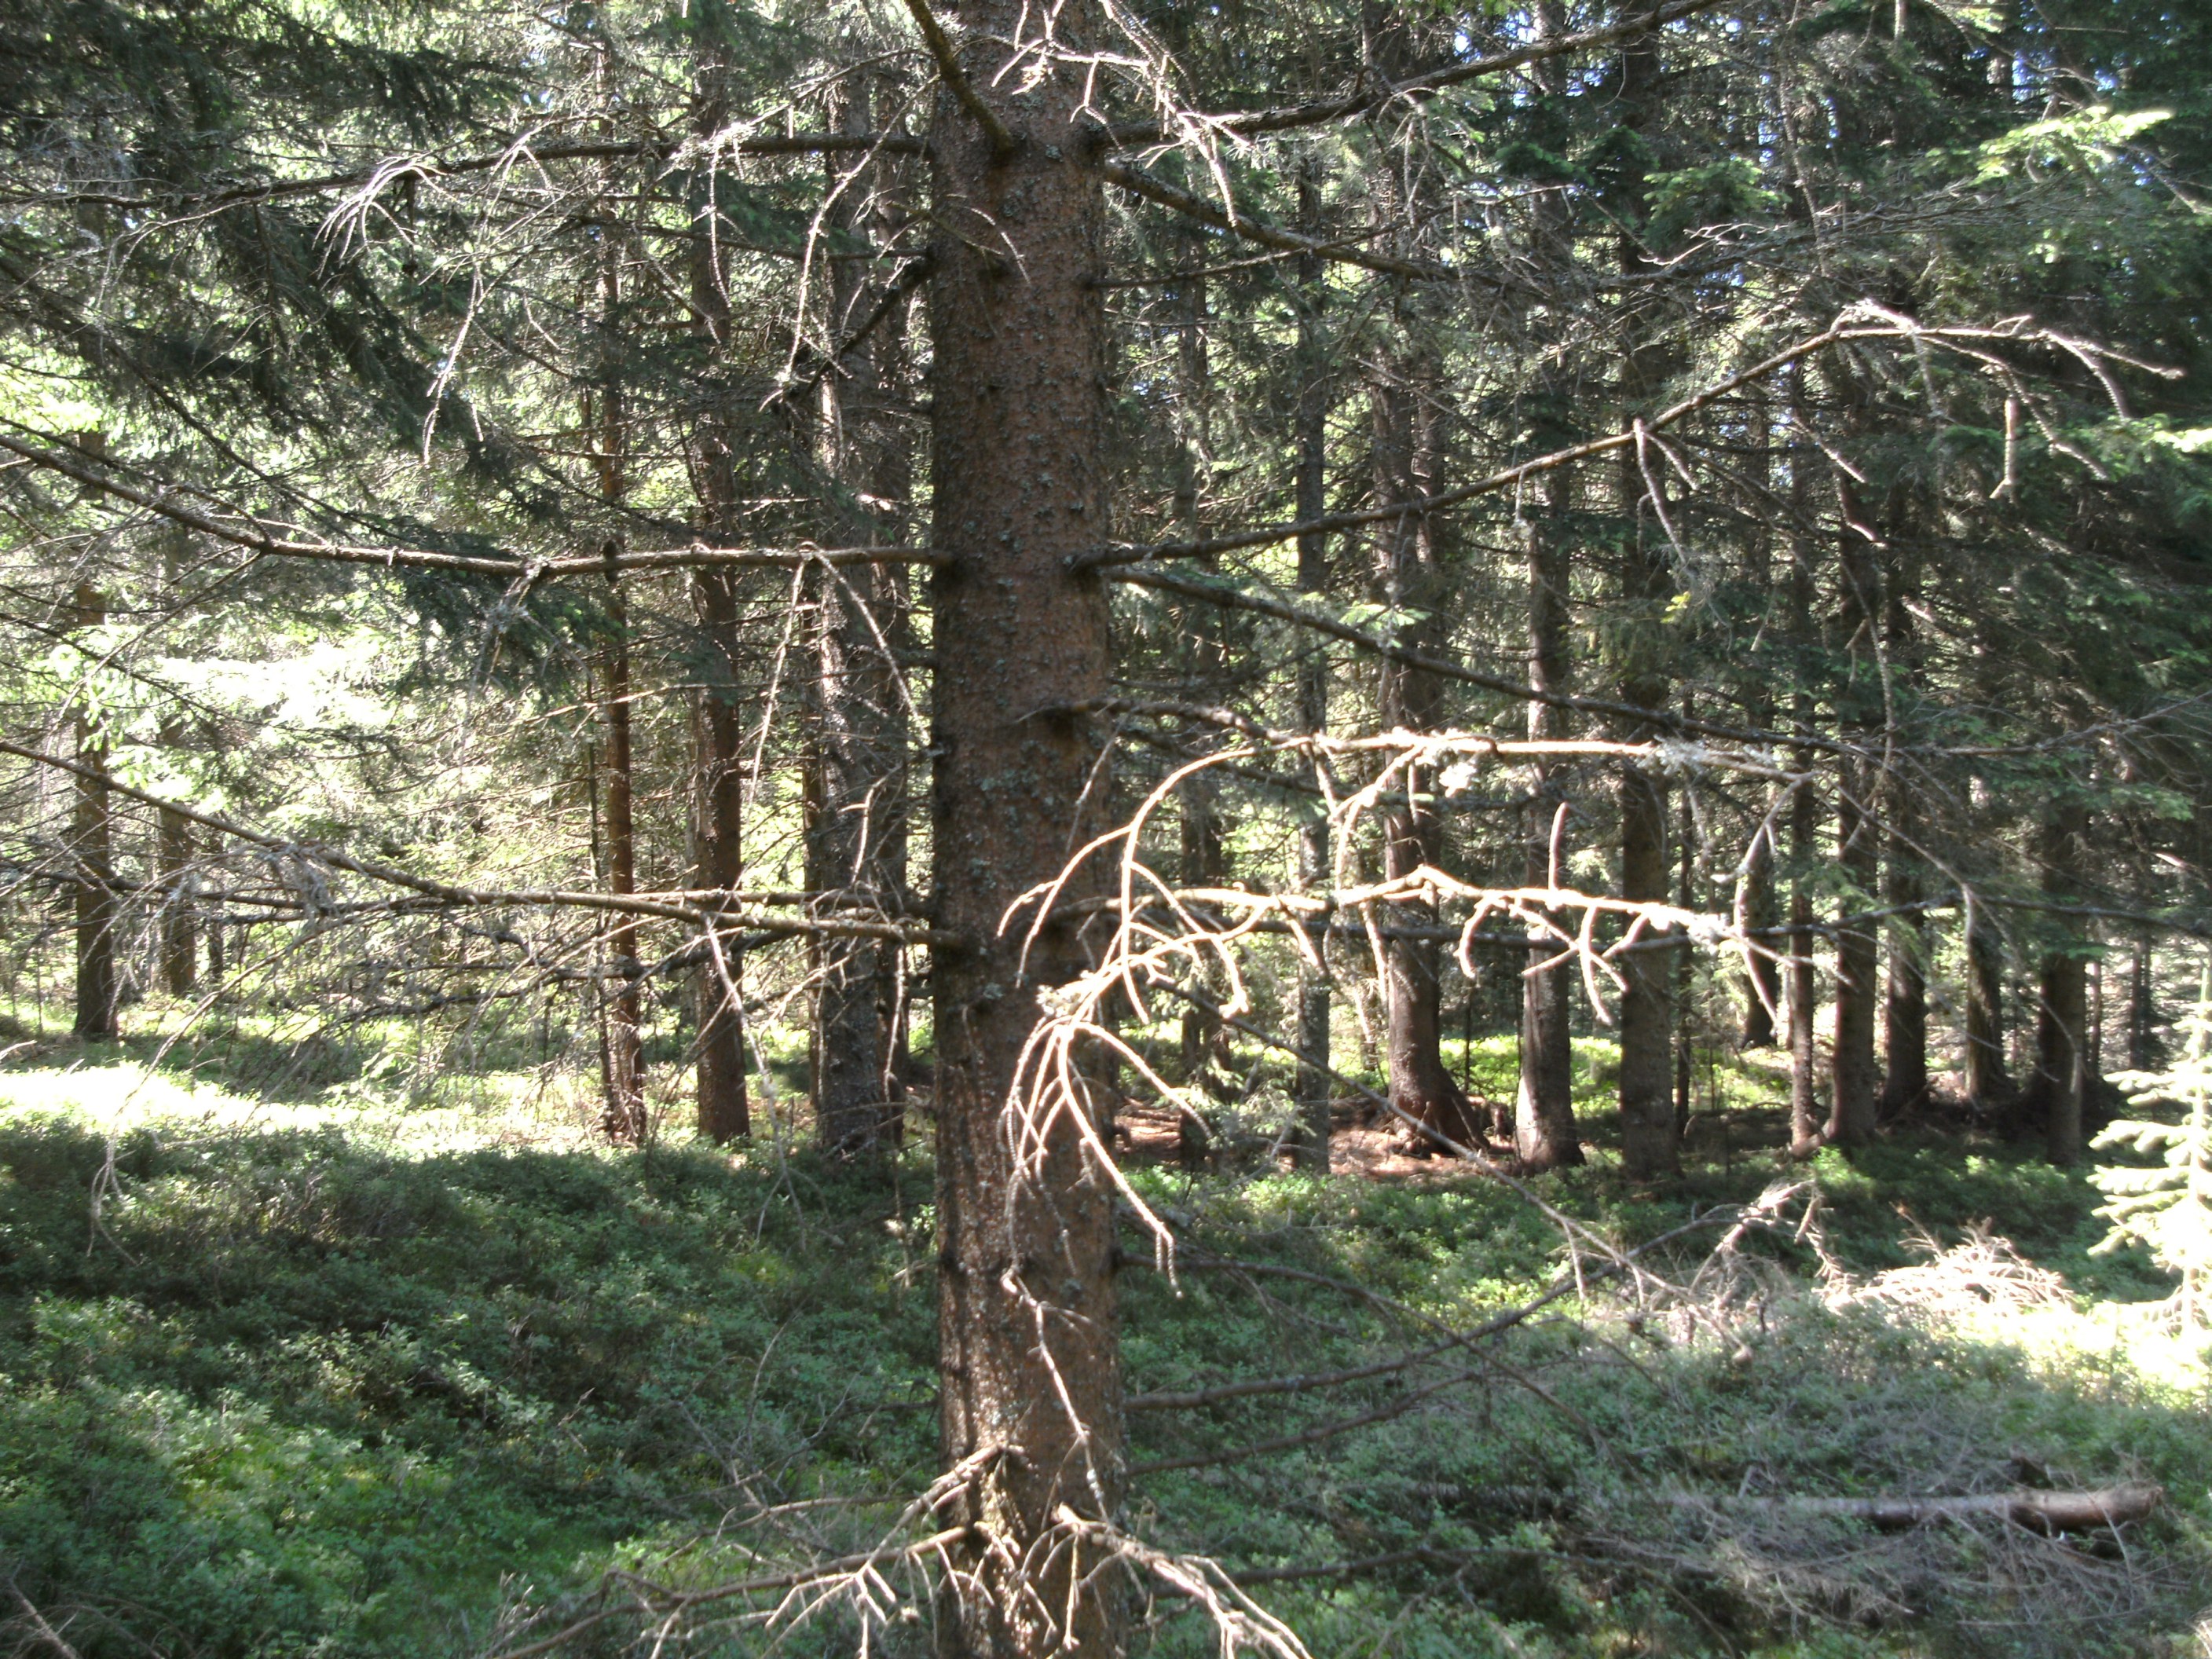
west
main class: Woodland
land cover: Spruce dominated coniferous woodland
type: alpine coniferous forest
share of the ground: 50 - 75 %
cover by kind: coniferous forest trees 75 %, shrubs 15 %, herbaceous plants 10 %
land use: Forestry
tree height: > 5 m
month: July
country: AT
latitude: 46.9043
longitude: 14.9478
